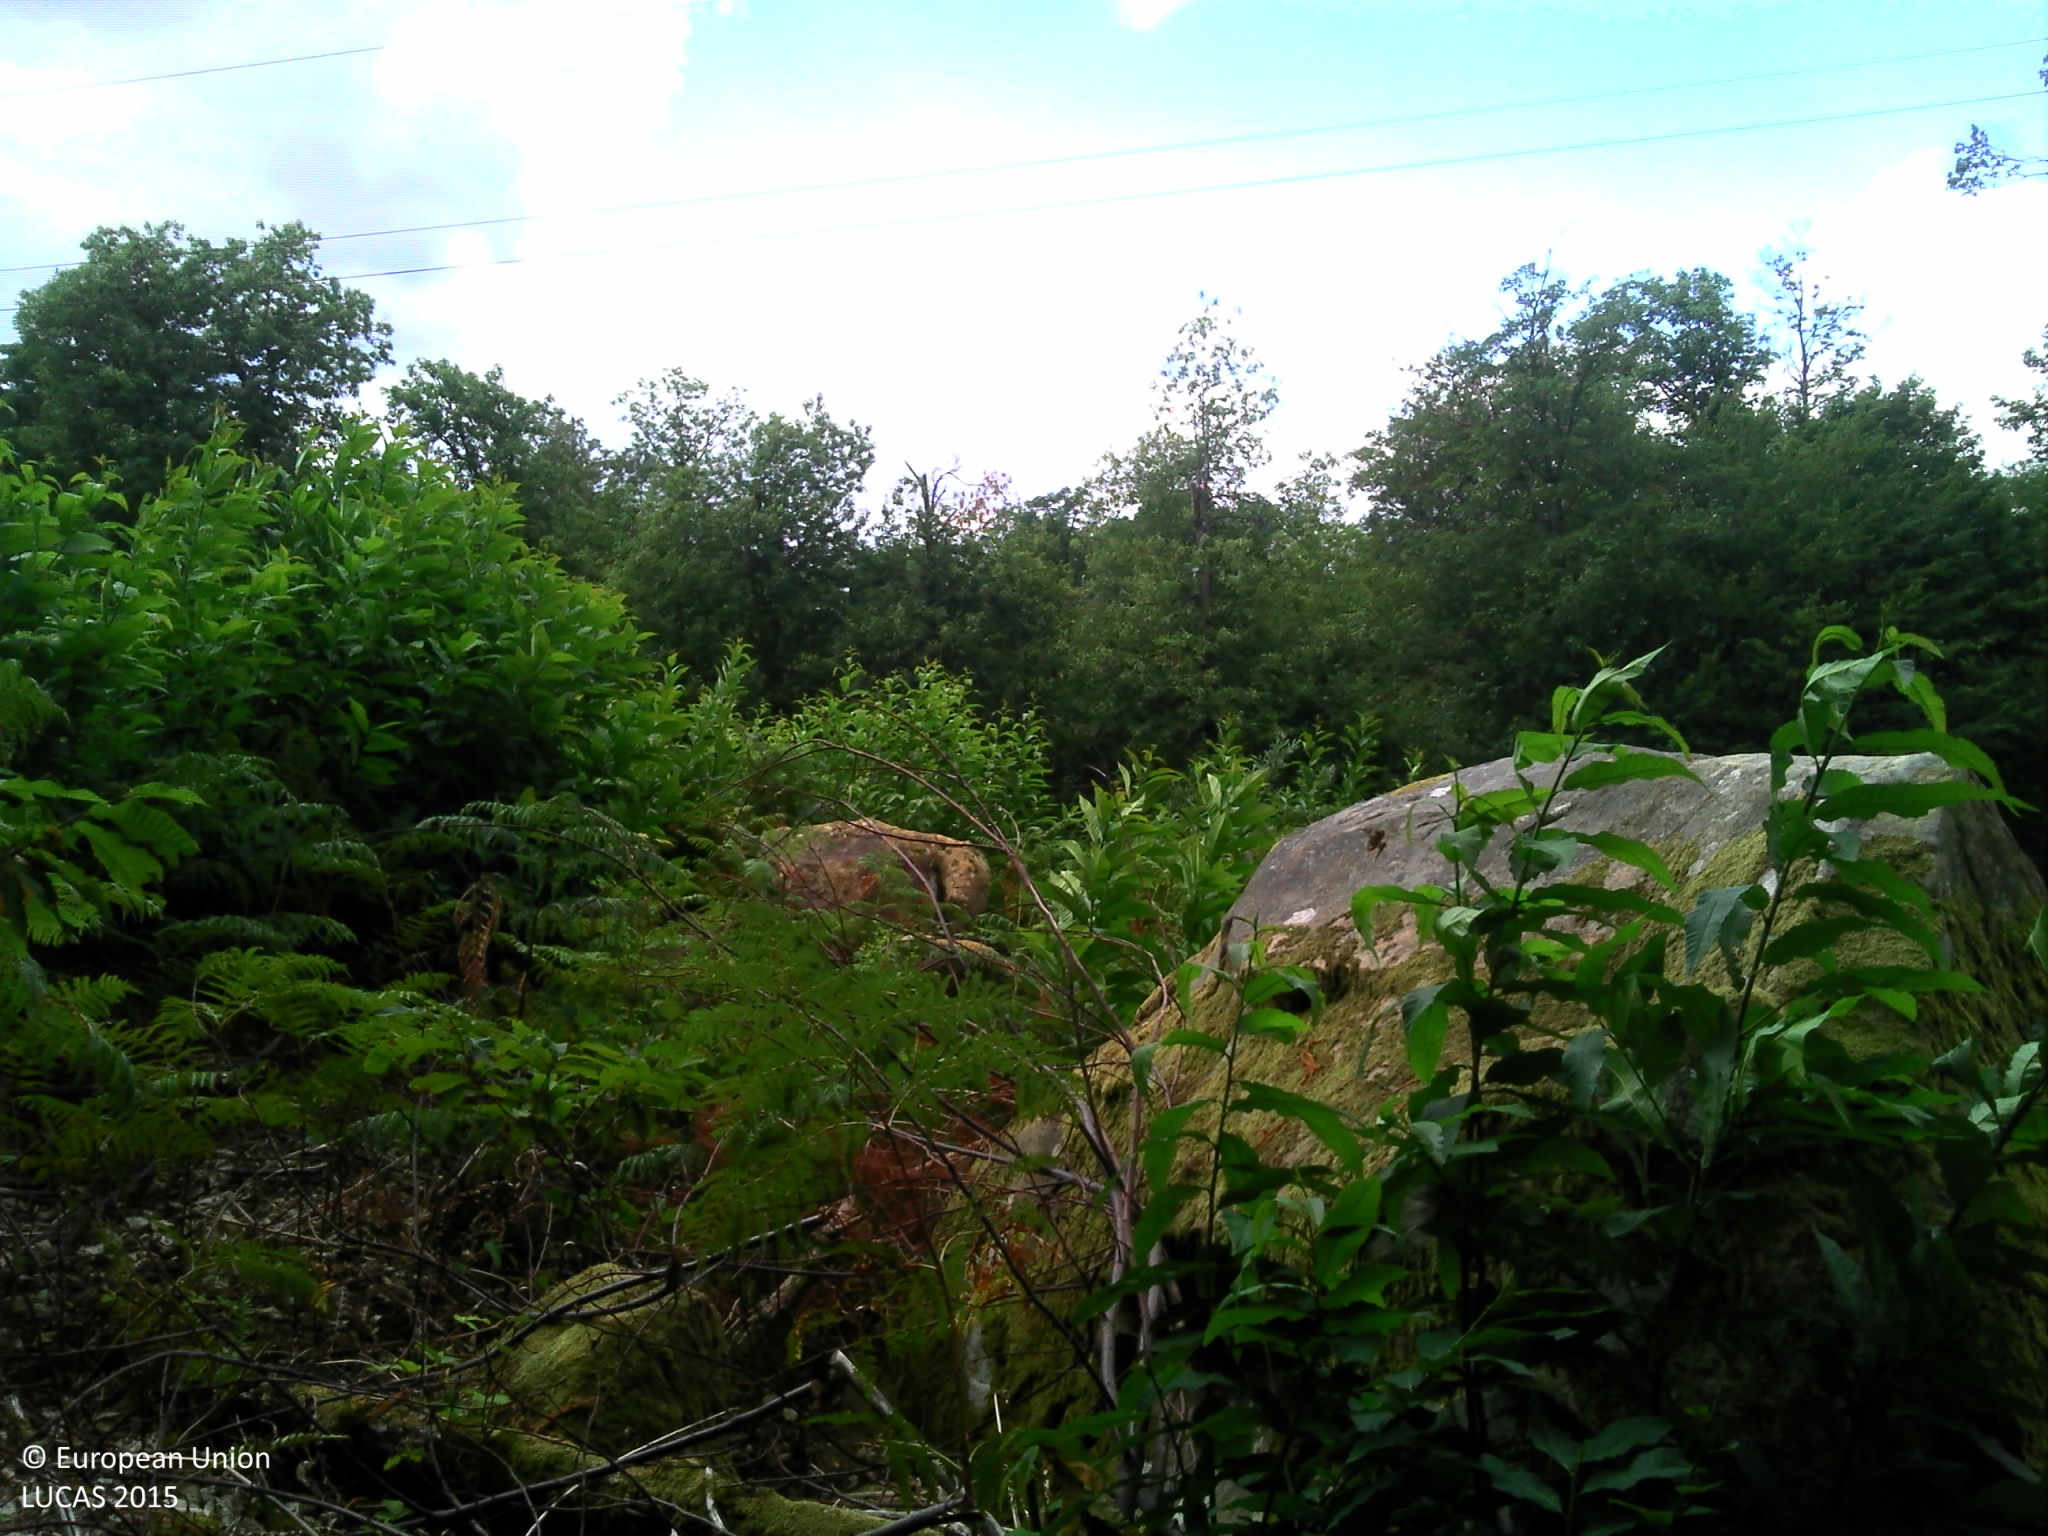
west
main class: Woodland
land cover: Broadleaved woodland
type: thermophilous deciduous forest
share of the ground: > 75 %
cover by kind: broadleaved forest trees 55 %, lichens and mosses 15 %, shrubs 10 %, herbaceous plants 10 %
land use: Forestry
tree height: > 5 m
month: July
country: FR
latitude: 48.4190
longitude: 2.7618
